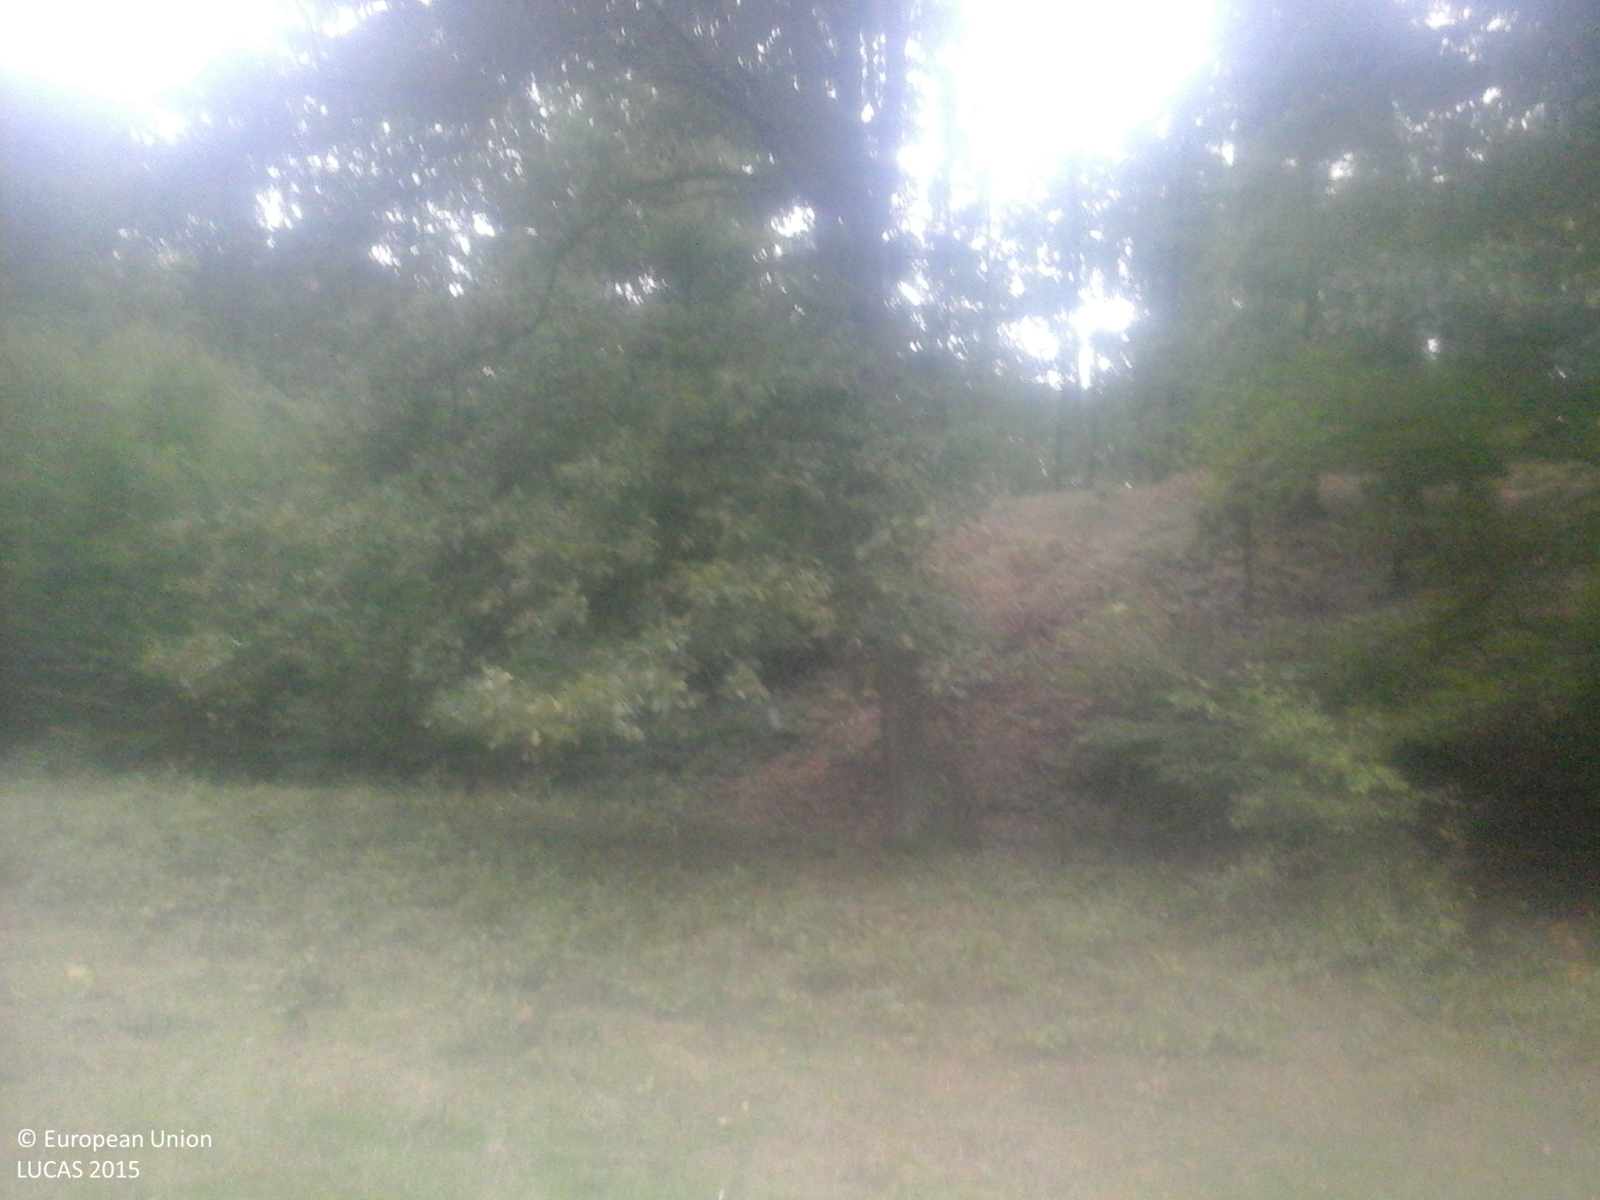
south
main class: Grassland
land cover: Grassland without tree/shrub cover
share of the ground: > 75 %
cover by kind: herbaceous plants 100 %
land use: Agriculture (excluding fallow land and kitchen gardens)
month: September
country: RO
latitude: 45.9190
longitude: 23.4335
